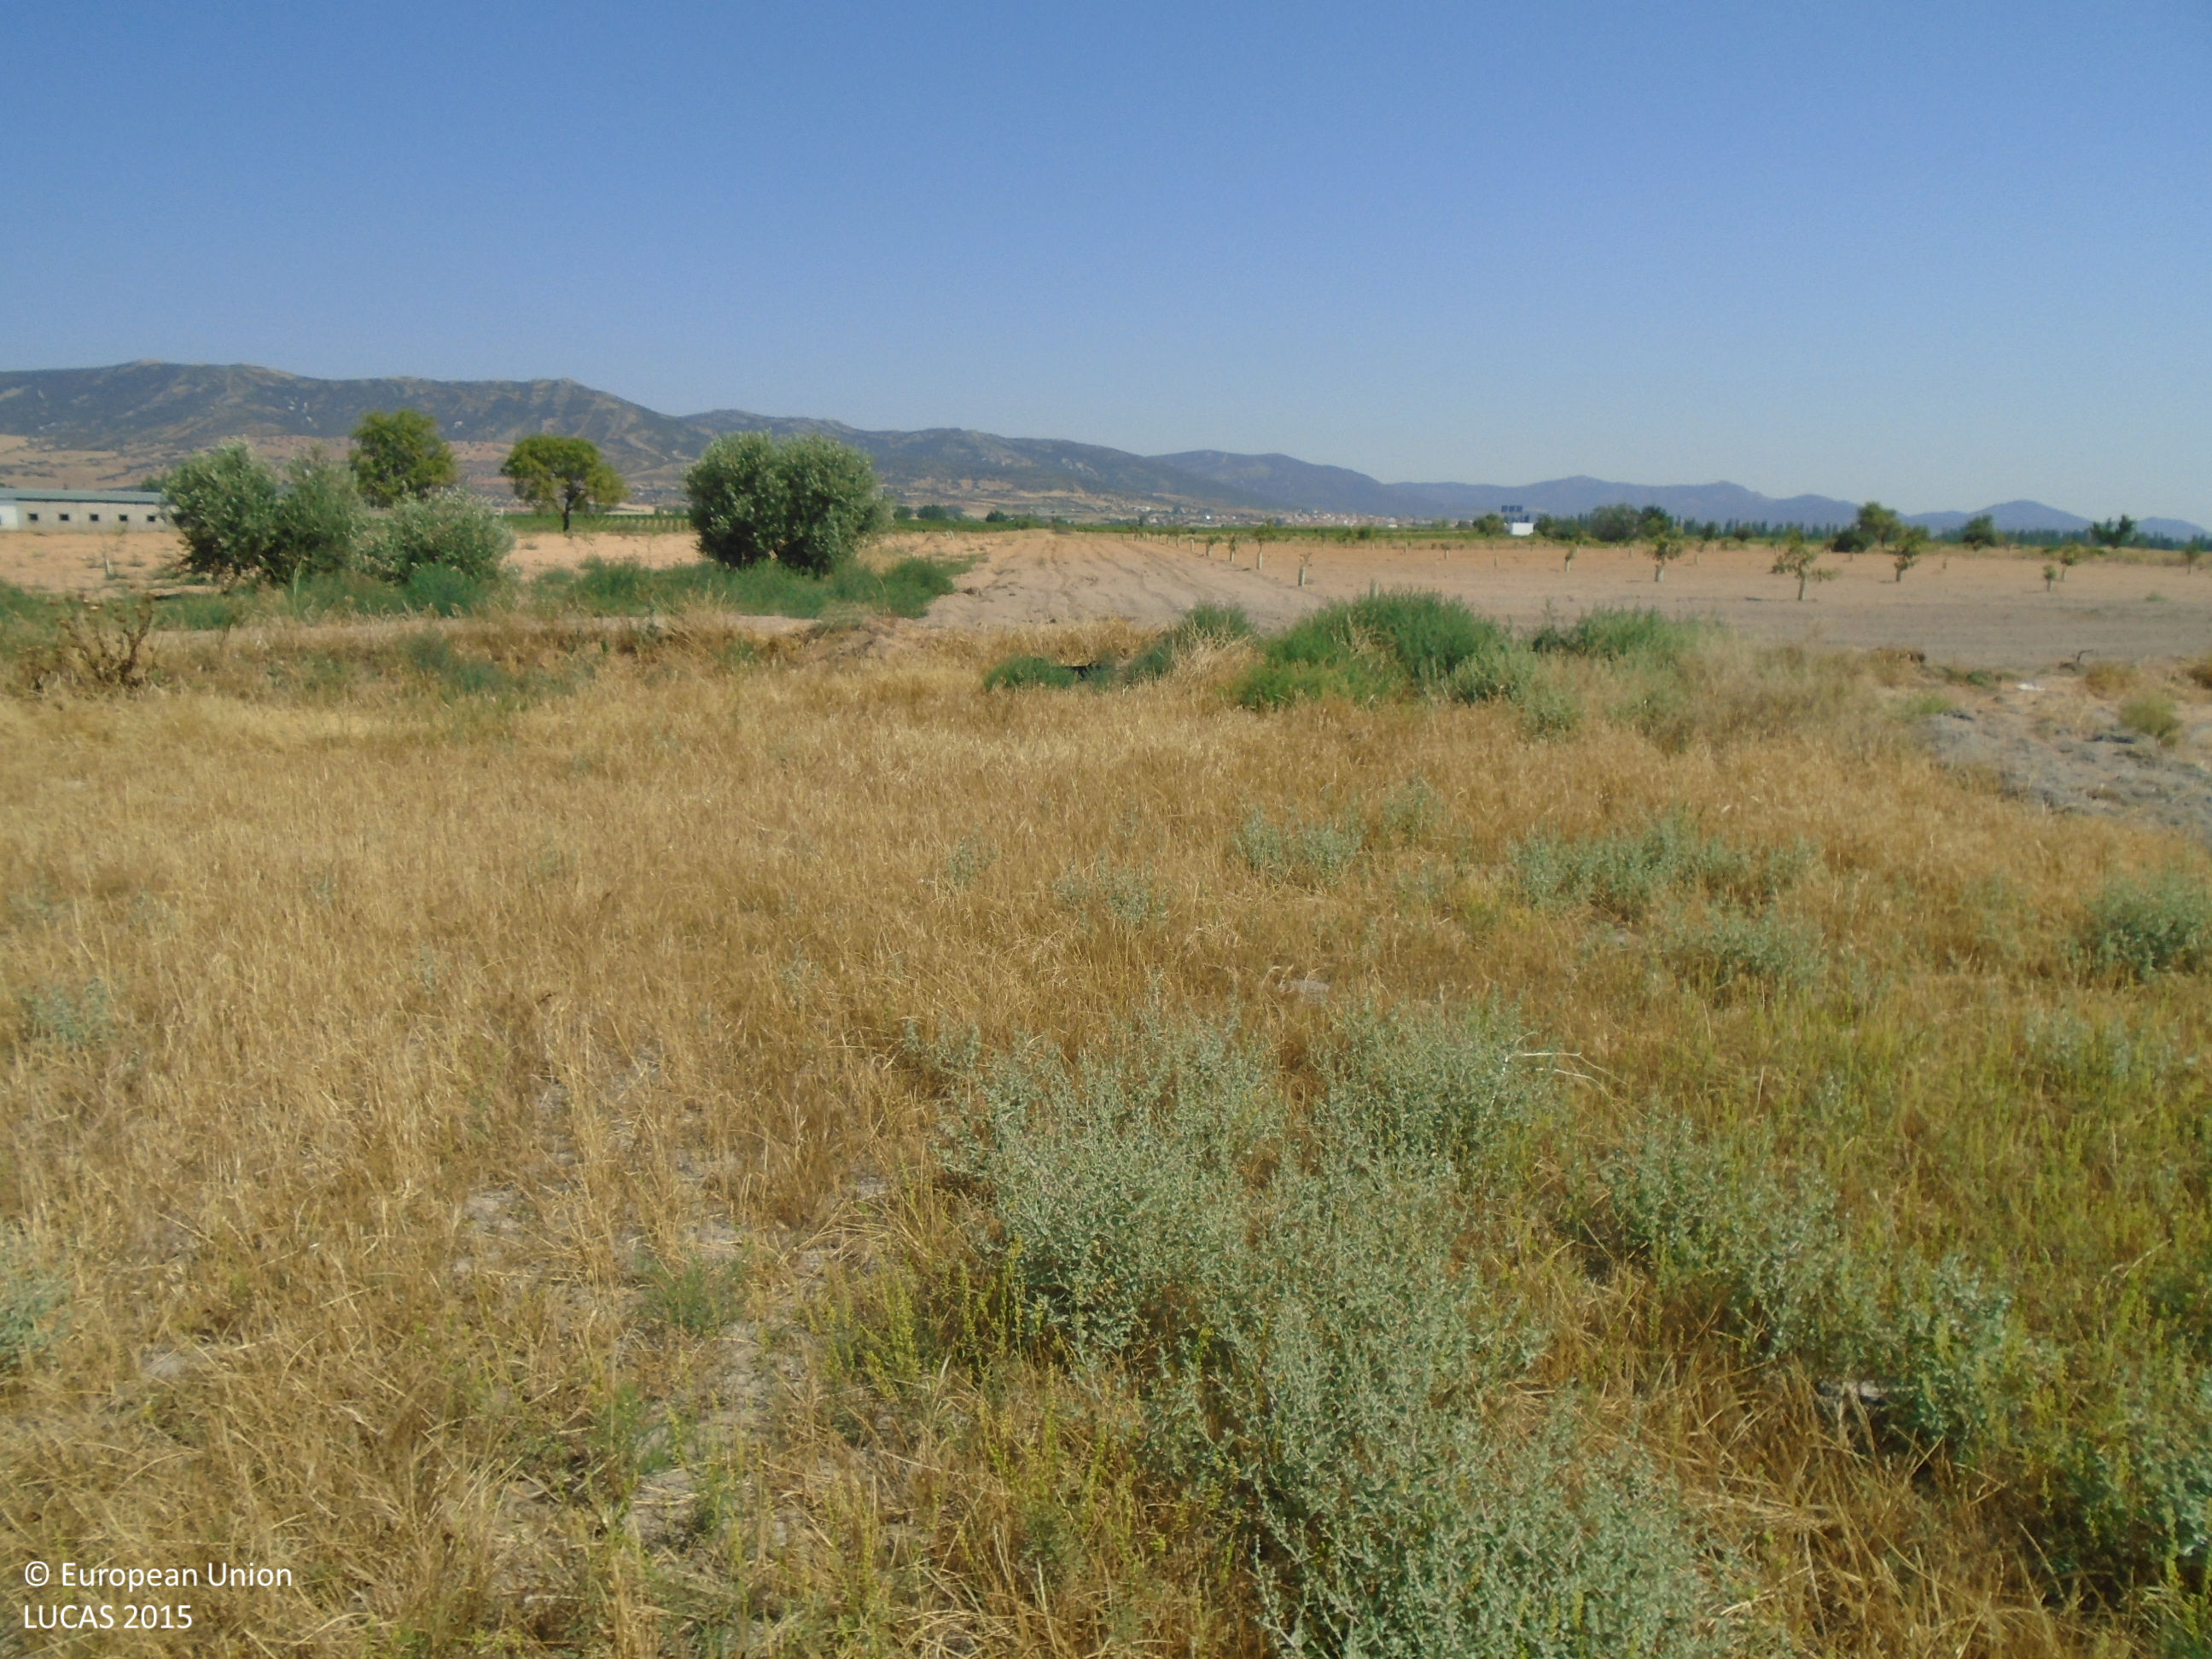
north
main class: Cropland
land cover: Barley
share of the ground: > 75 %
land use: Agriculture (excluding fallow land and kitchen gardens)
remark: Harvested field
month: June
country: ES
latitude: 39.1840
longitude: -3.6223
